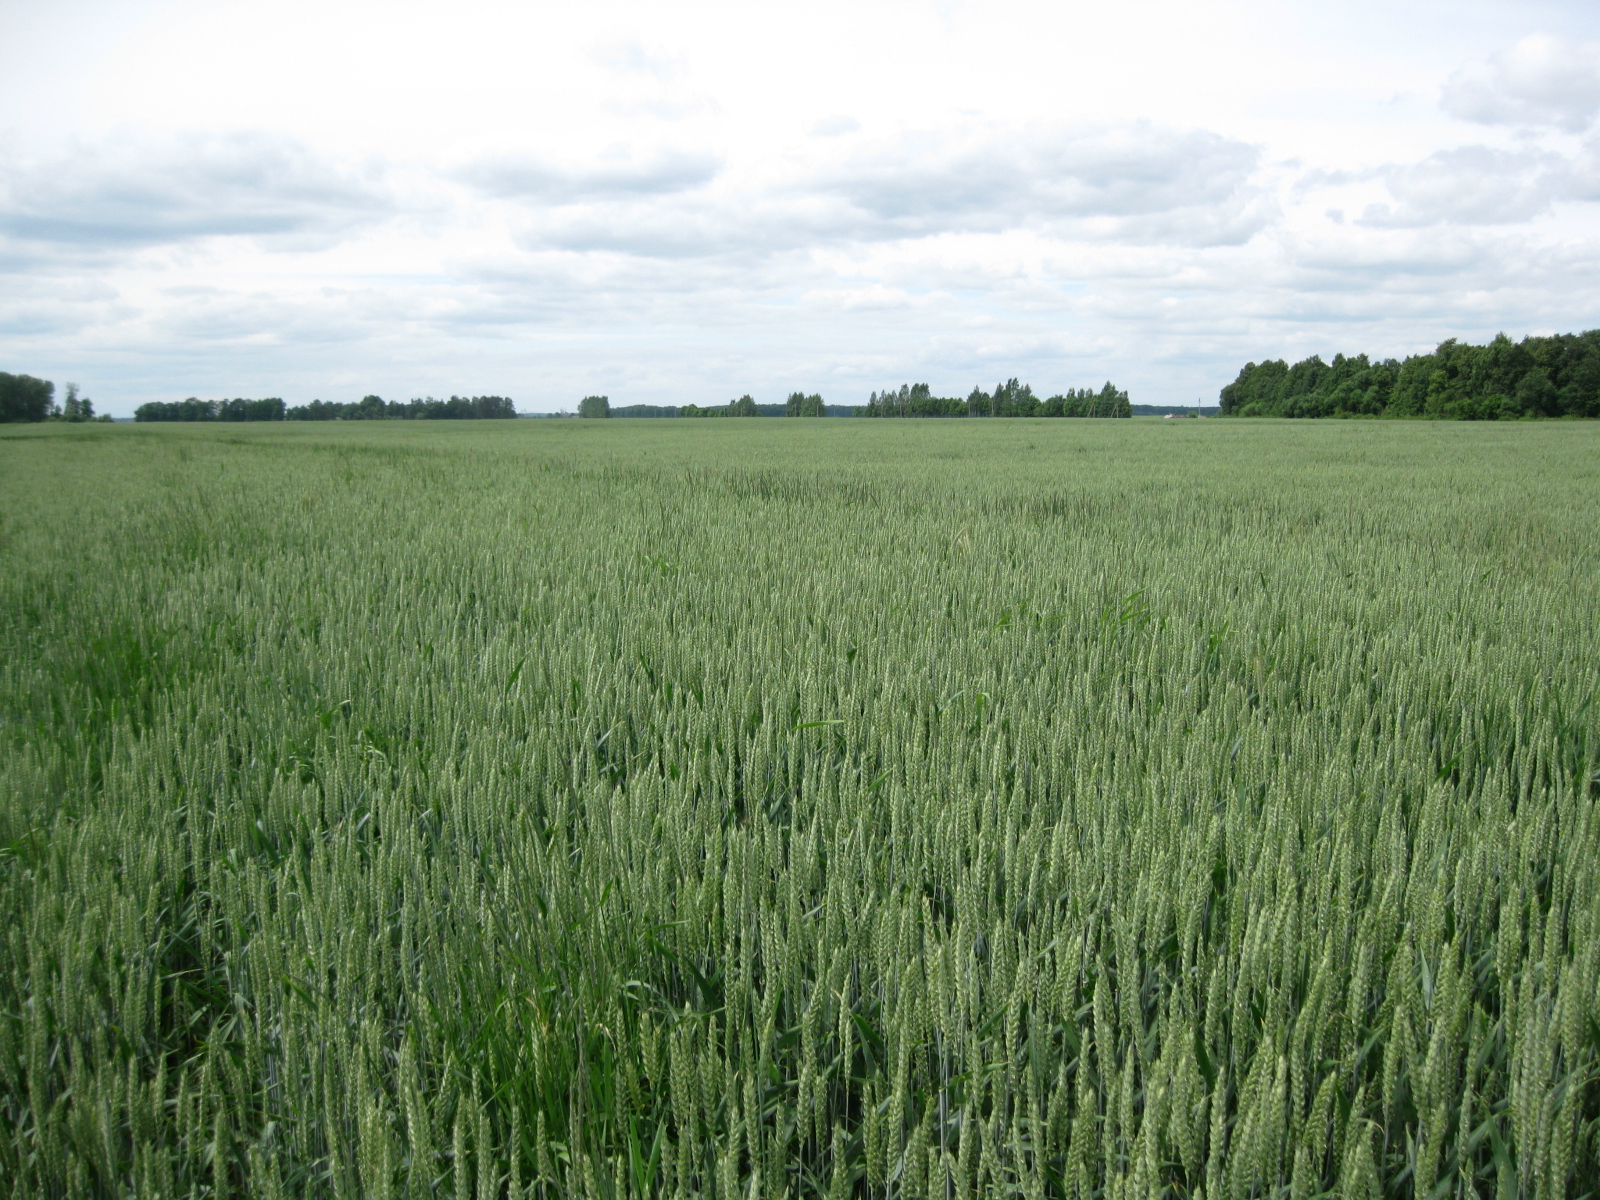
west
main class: Cropland
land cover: Common wheat
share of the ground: > 75 %
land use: Agriculture (excluding fallow land and kitchen gardens)
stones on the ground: < 10 %
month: June
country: LT
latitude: 55.5900
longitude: 24.2313
